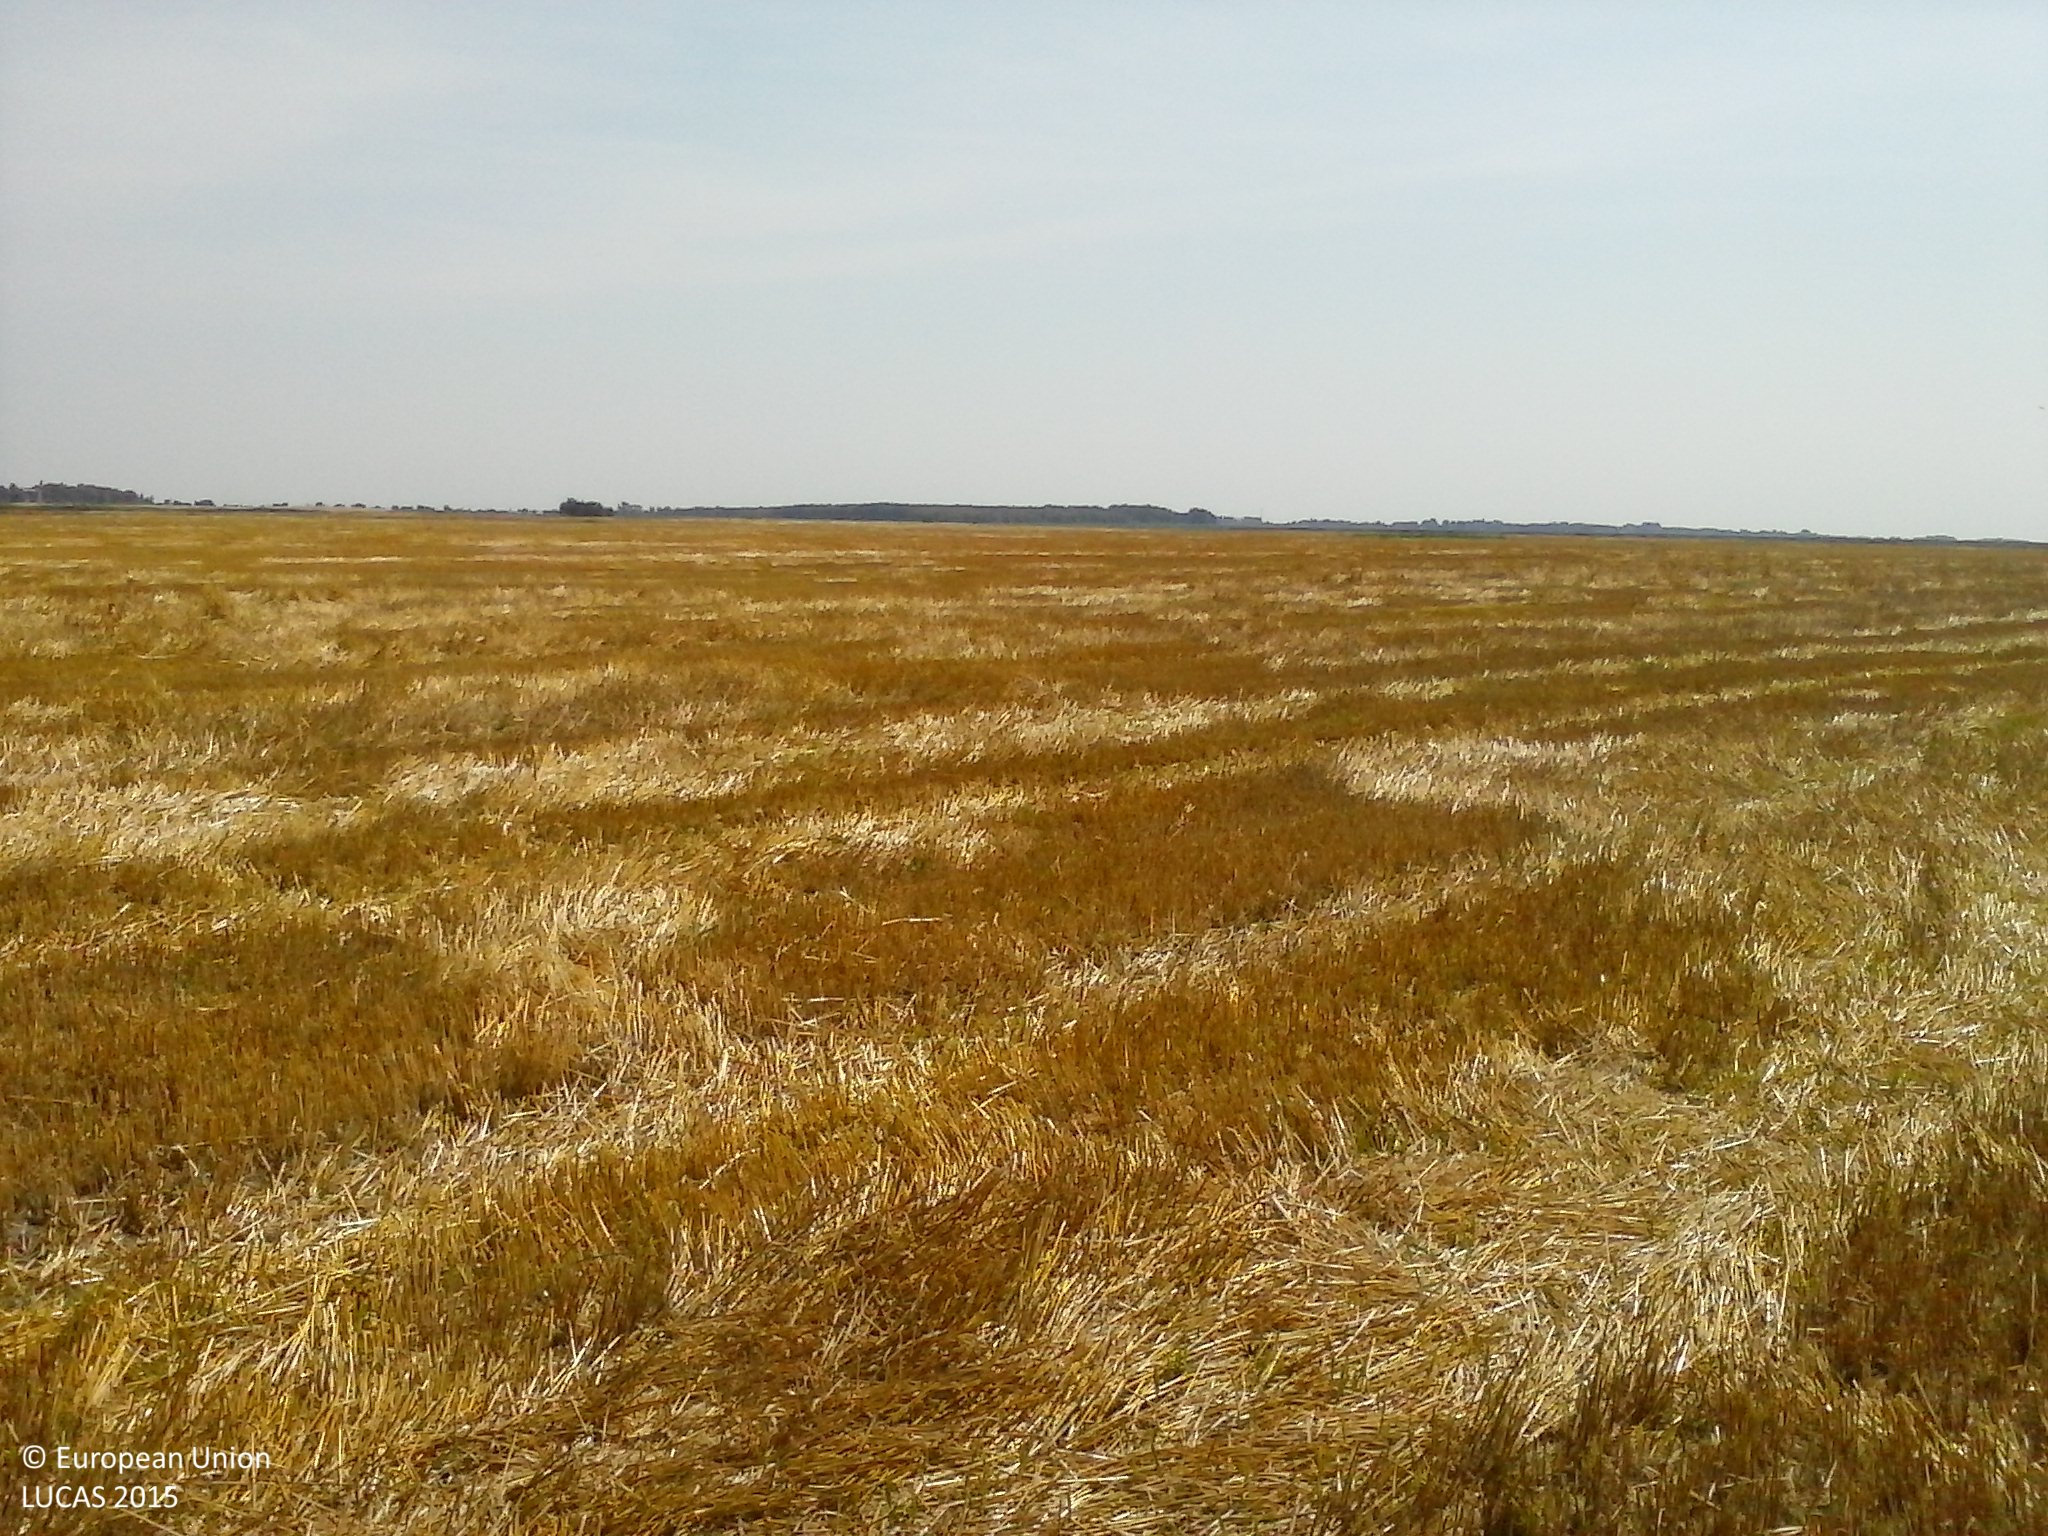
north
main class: Cropland
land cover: Common wheat
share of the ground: > 75 %
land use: Agriculture (excluding fallow land and kitchen gardens)
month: June
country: HU
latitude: 46.6607
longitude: 20.3897
